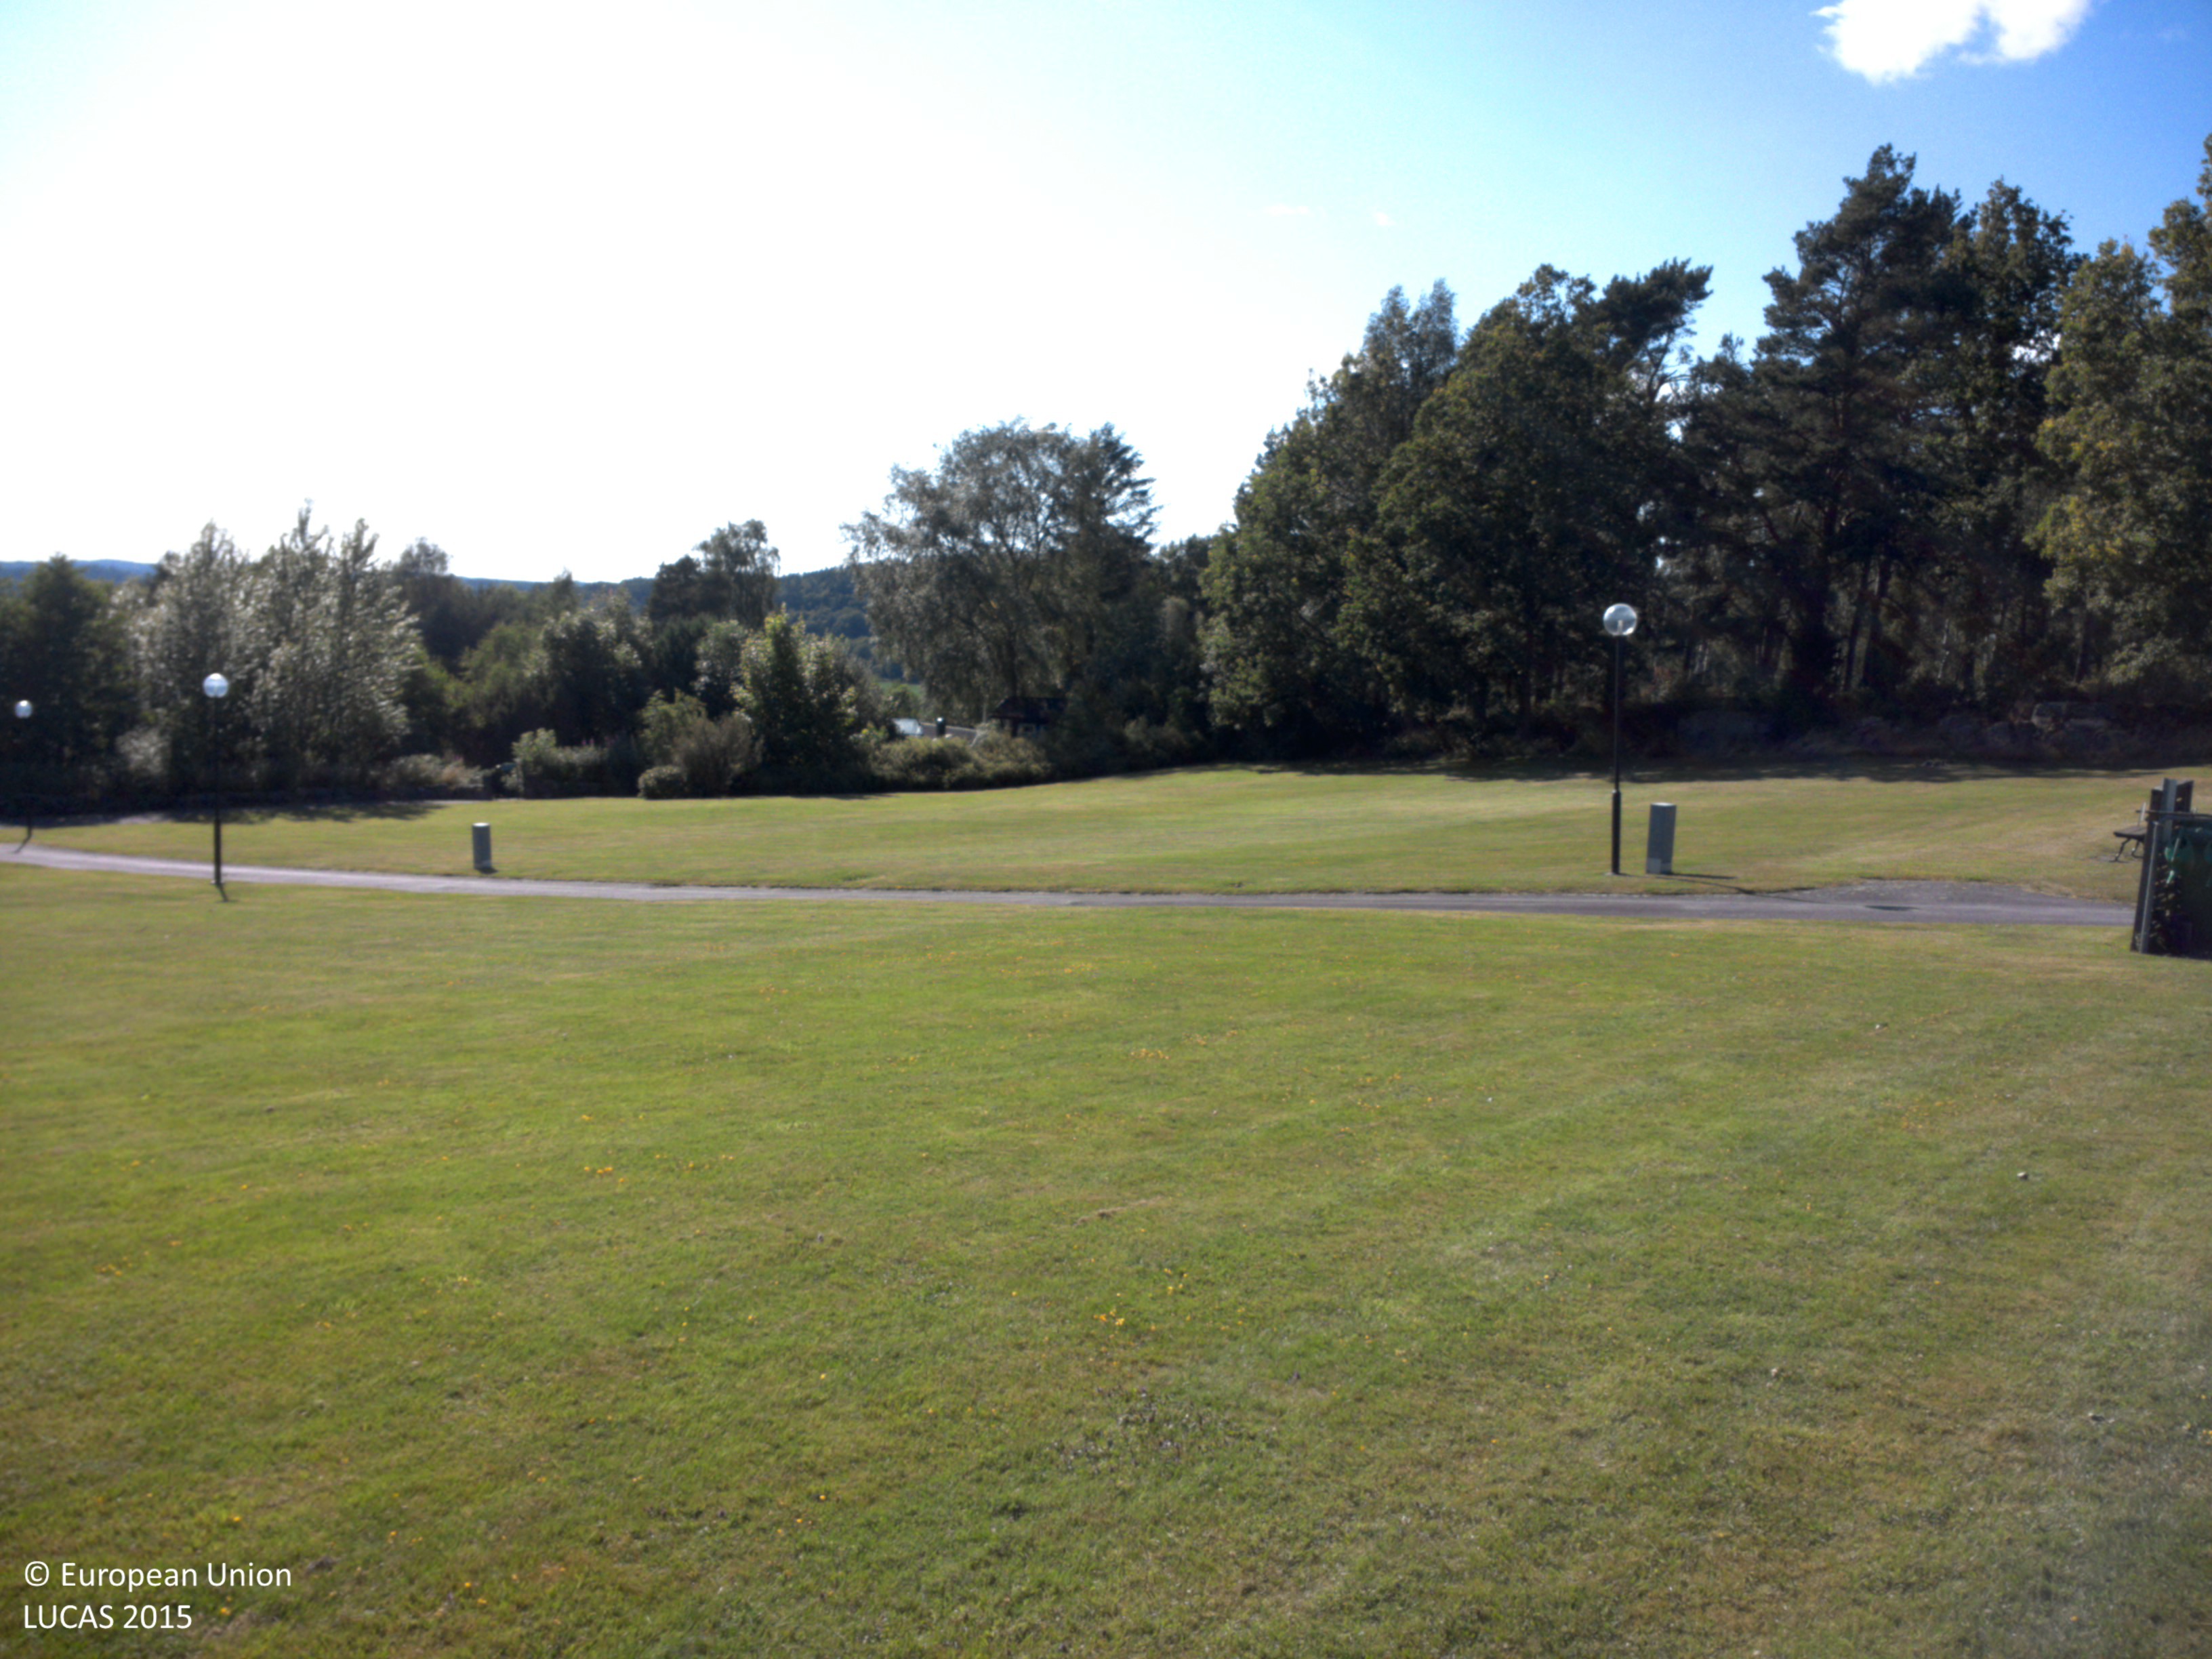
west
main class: Grassland
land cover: Grassland without tree/shrub cover
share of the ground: > 75 %
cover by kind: herbaceous plants 100 %
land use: Community services
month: July
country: SE
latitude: 57.9854
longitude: 12.2116
